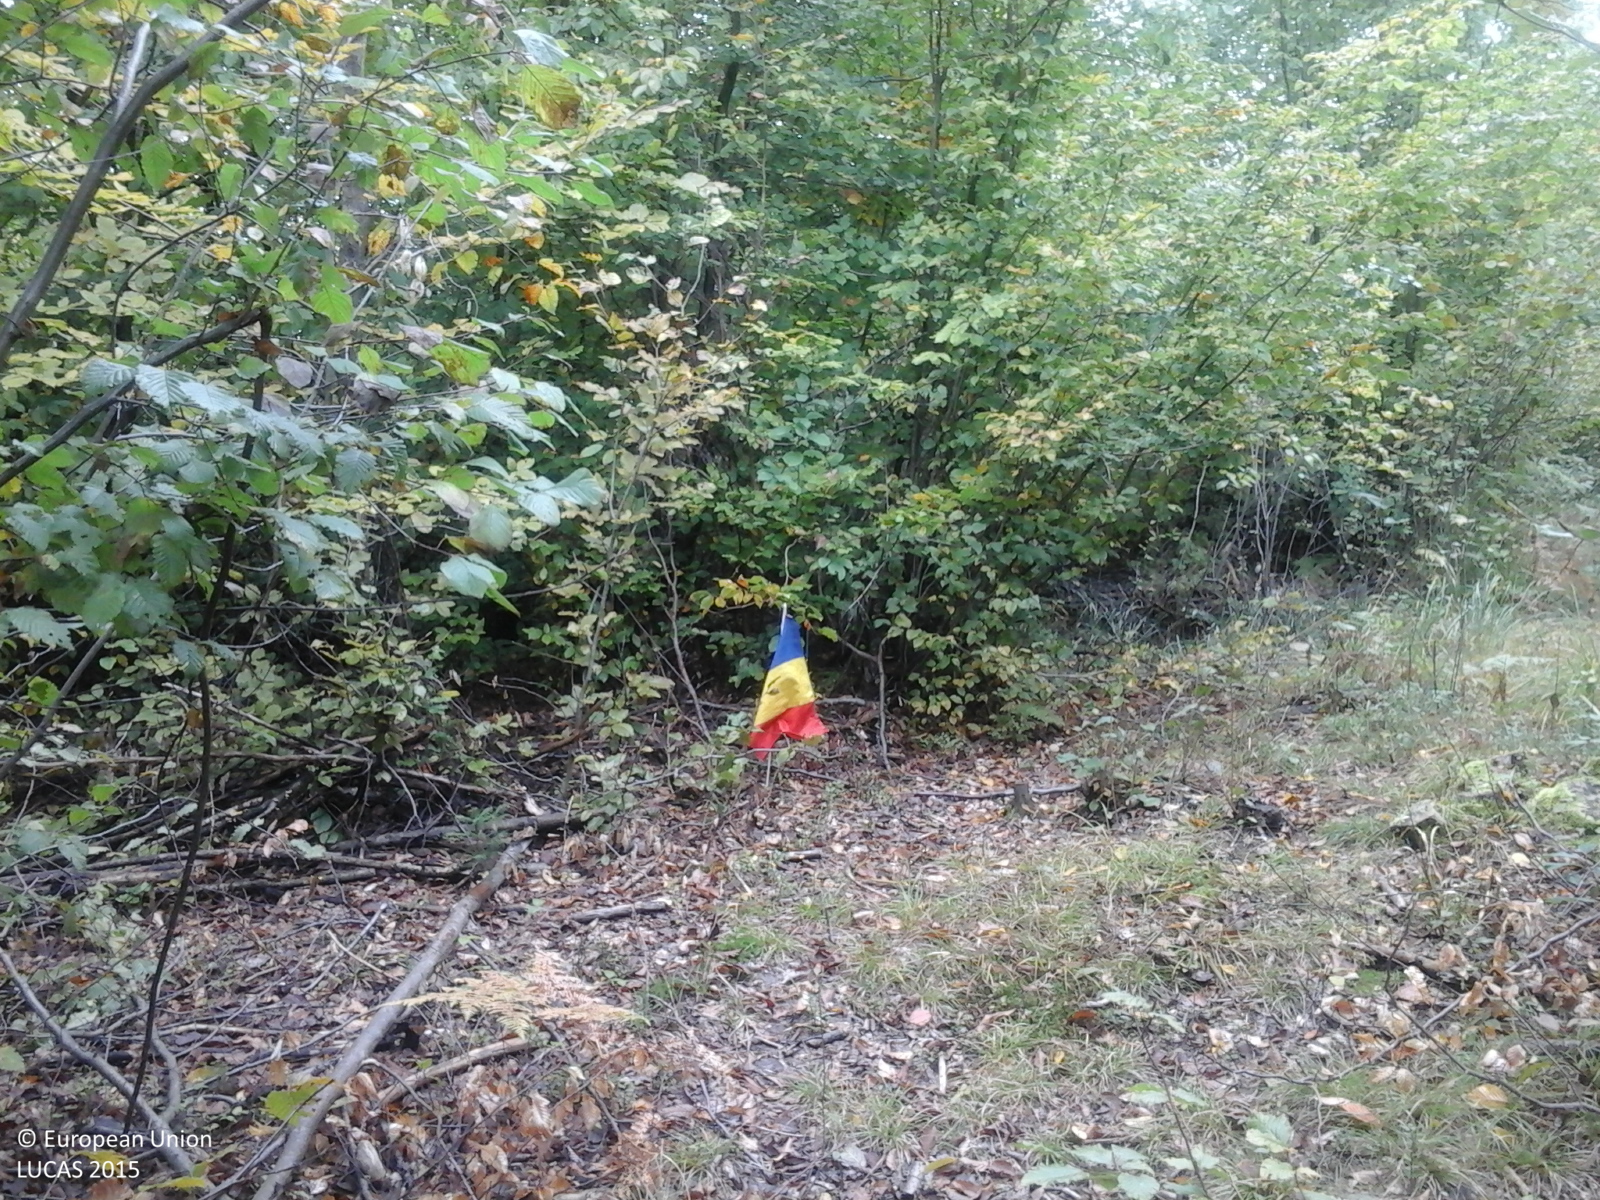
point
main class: Woodland
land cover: Broadleaved woodland
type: beech forest
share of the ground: > 75 %
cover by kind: broadleaved forest trees 100 %
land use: Forestry
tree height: > 5 m
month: October
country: RO
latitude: 45.7028
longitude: 25.0295
